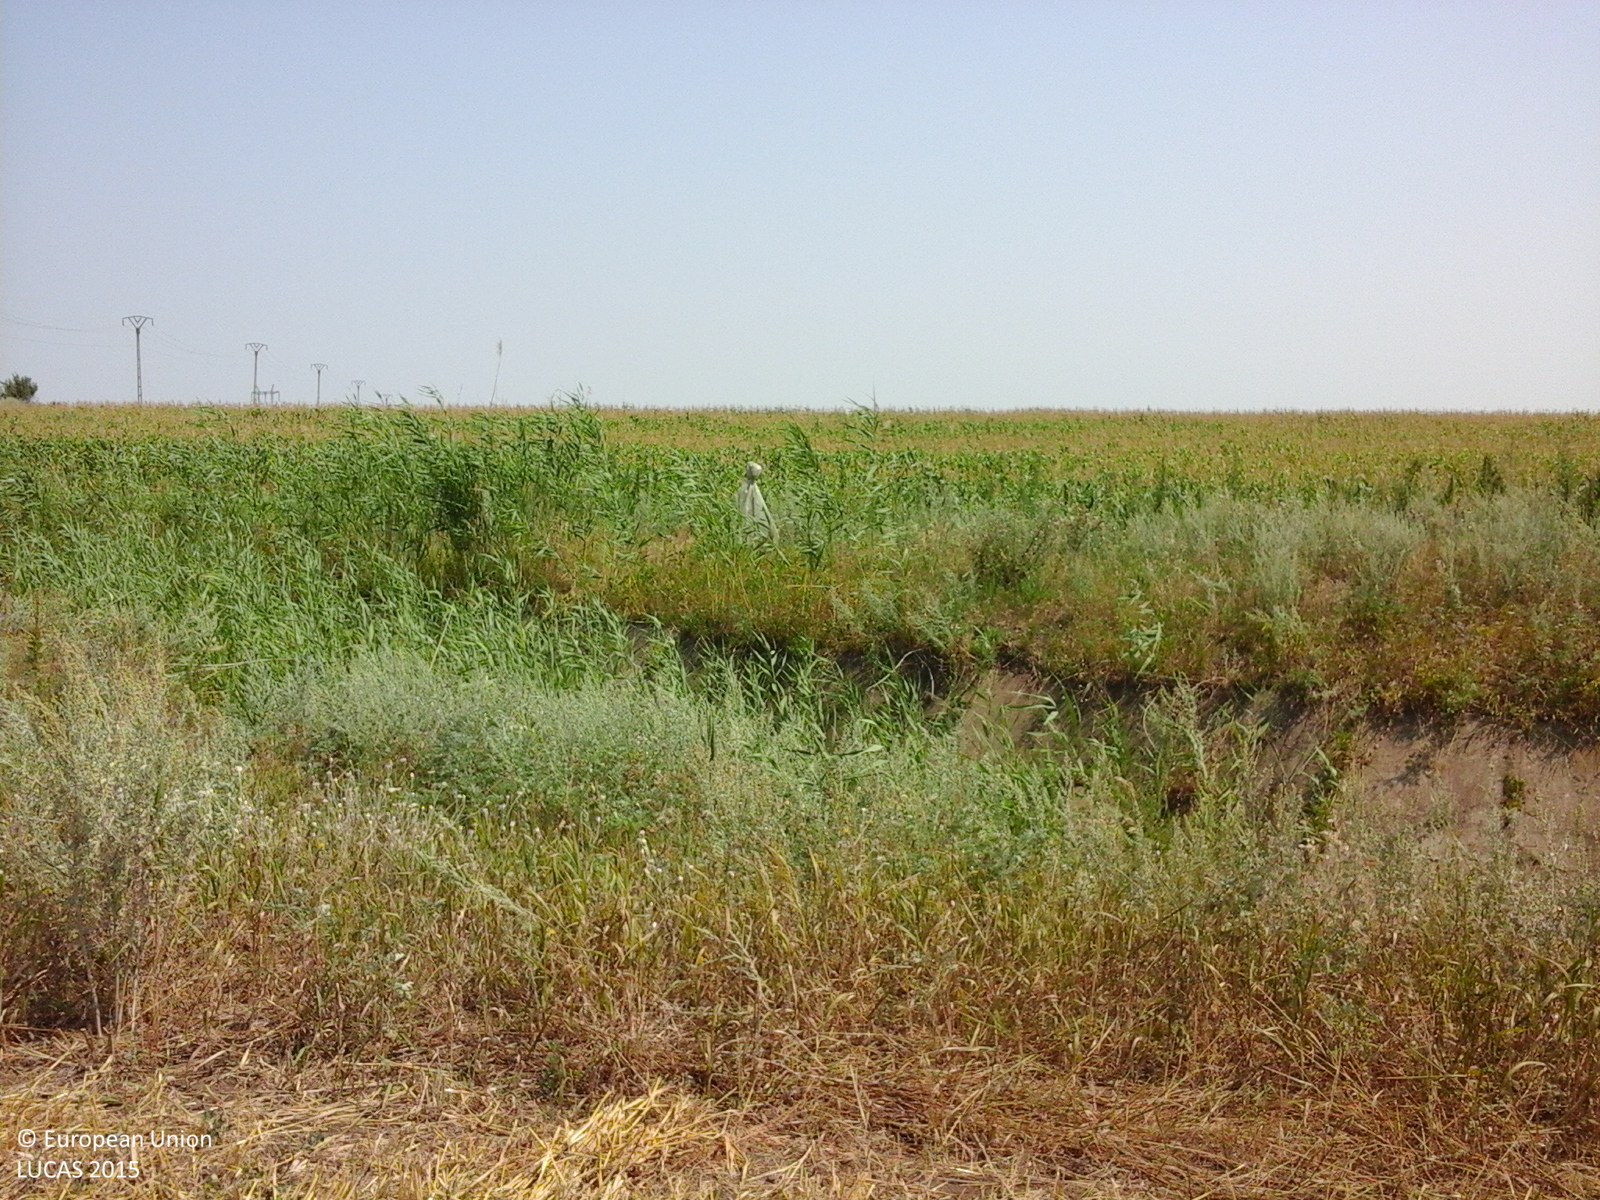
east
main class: Cropland
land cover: Barley
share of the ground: > 75 %
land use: Agriculture (excluding fallow land and kitchen gardens)
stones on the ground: < 10 %
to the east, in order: Barley; Grass margins; Ditches and canals; Grass margins; Maize; Common wheat
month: July
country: RO
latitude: 45.5084
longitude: 27.8930
